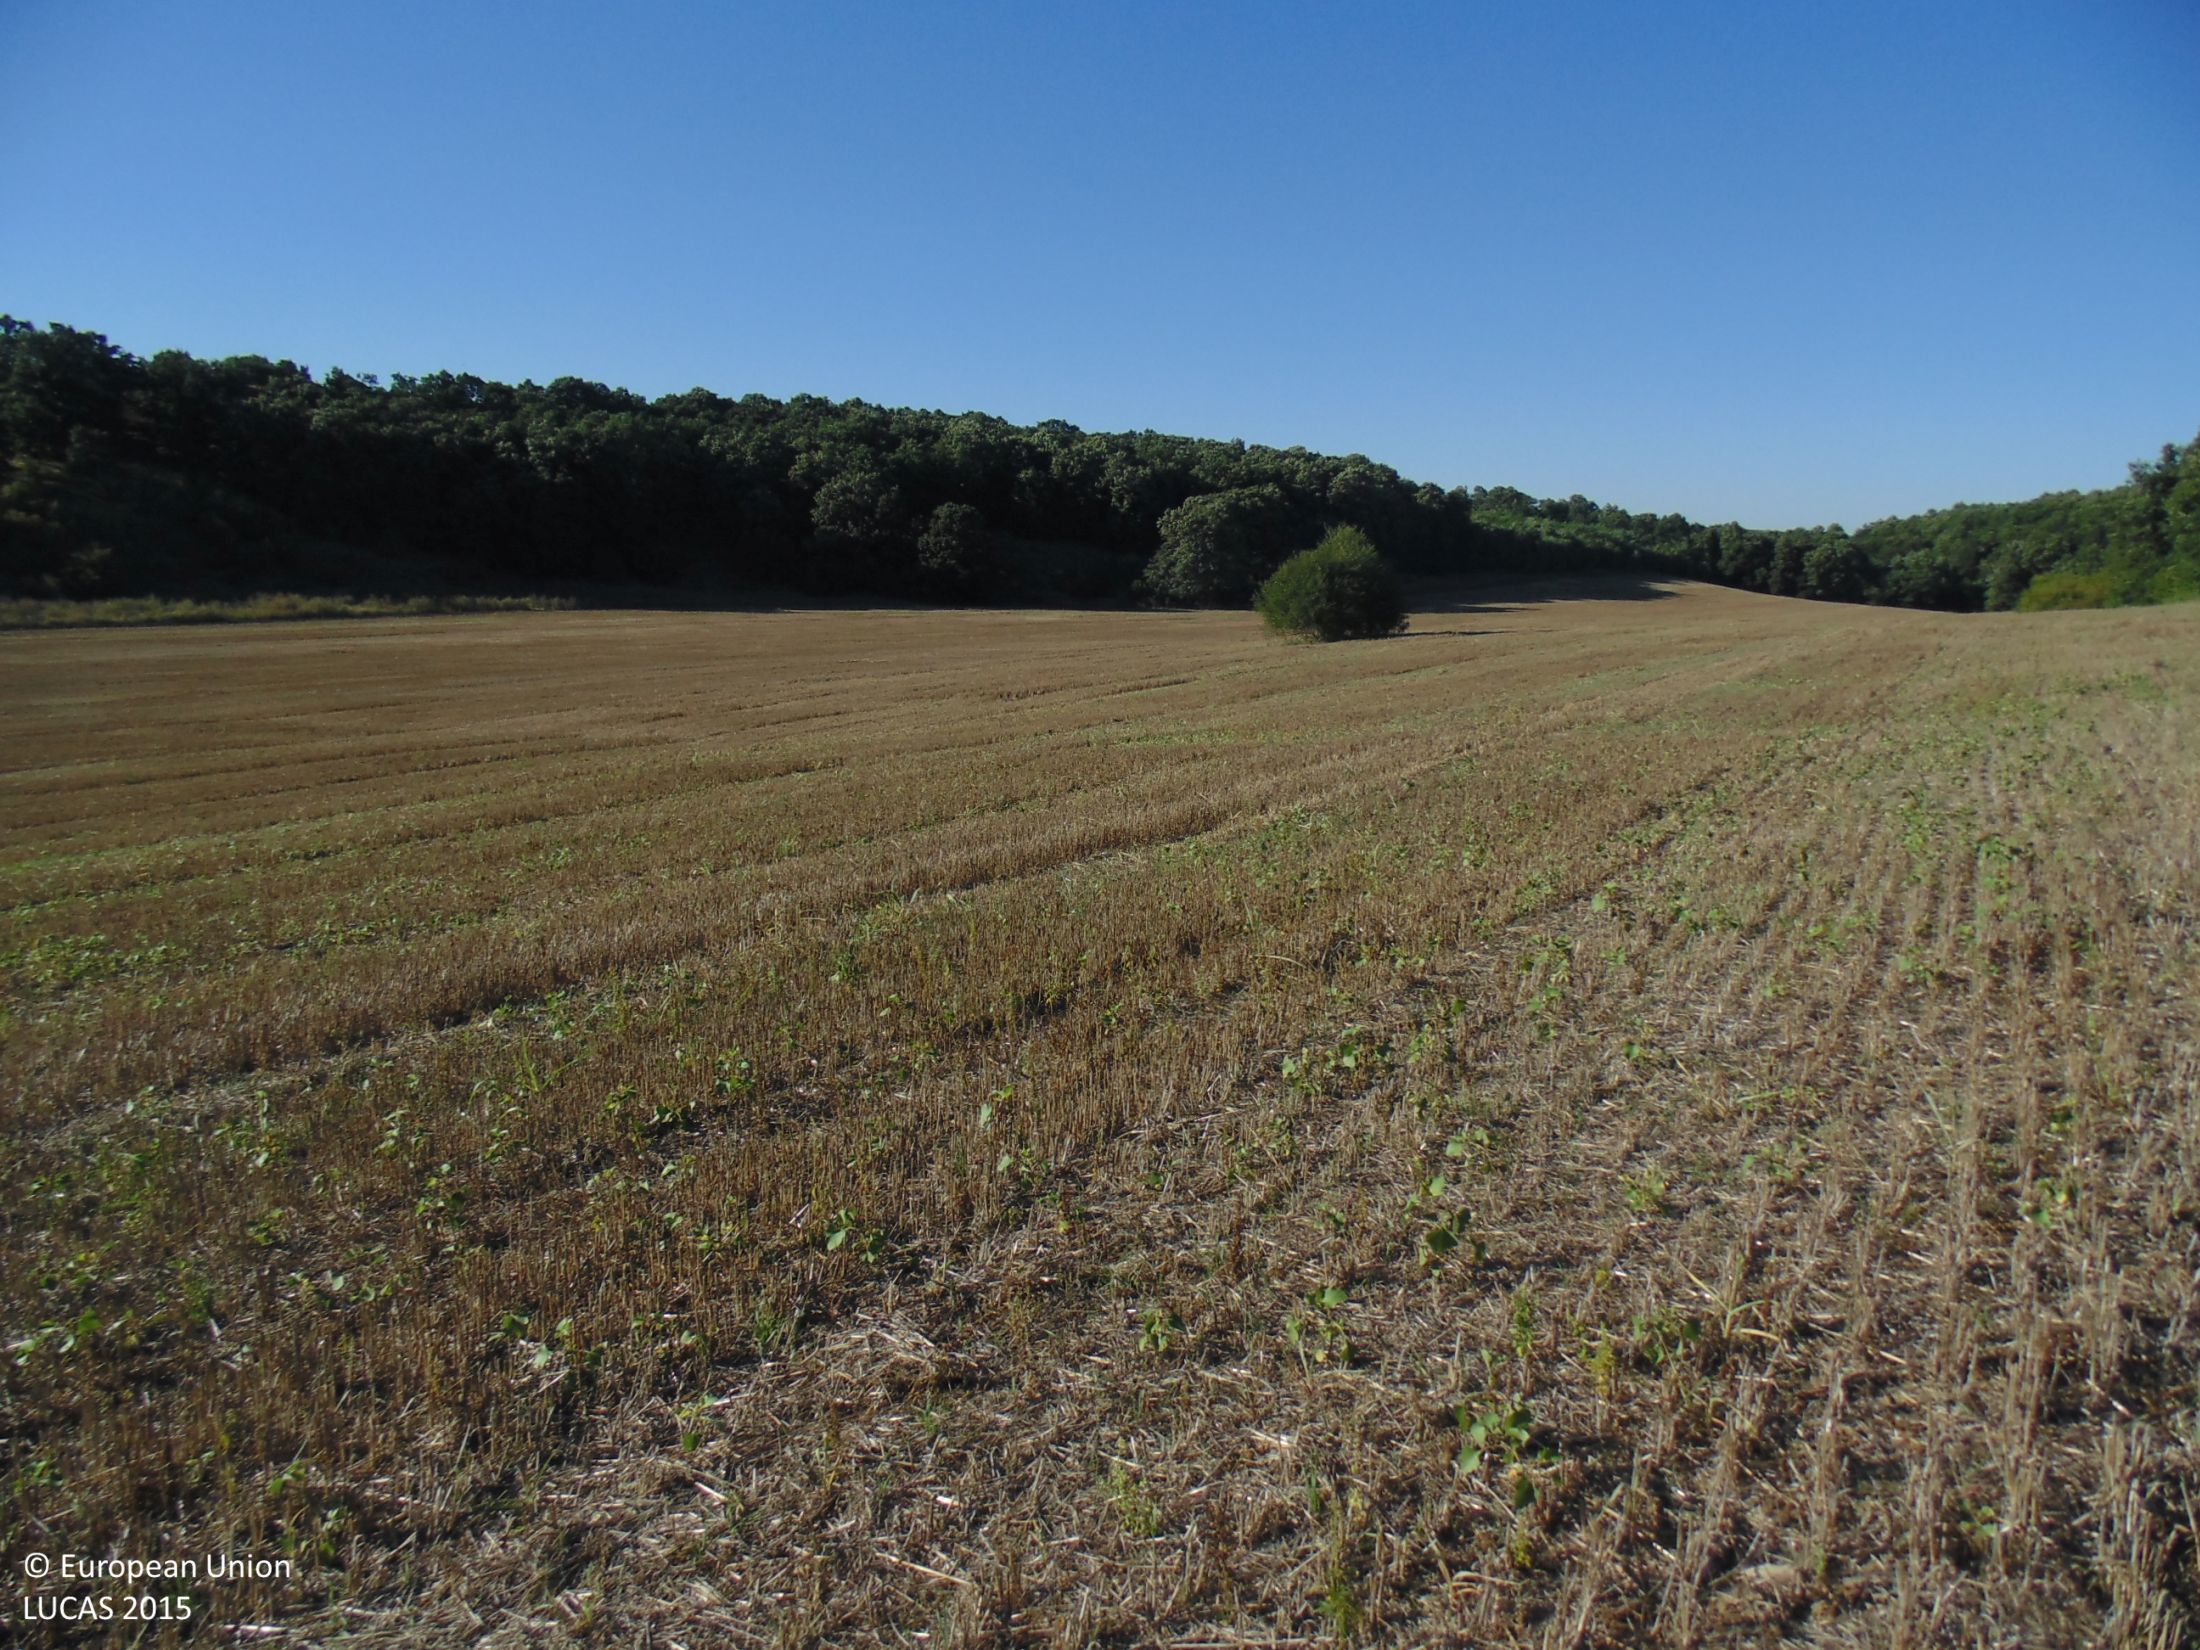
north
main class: Cropland
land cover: Common wheat
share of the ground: 25 - 50 %
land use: Agriculture (excluding fallow land and kitchen gardens)
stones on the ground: < 10 %
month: September
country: BG
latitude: 43.8004
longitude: 27.2171
